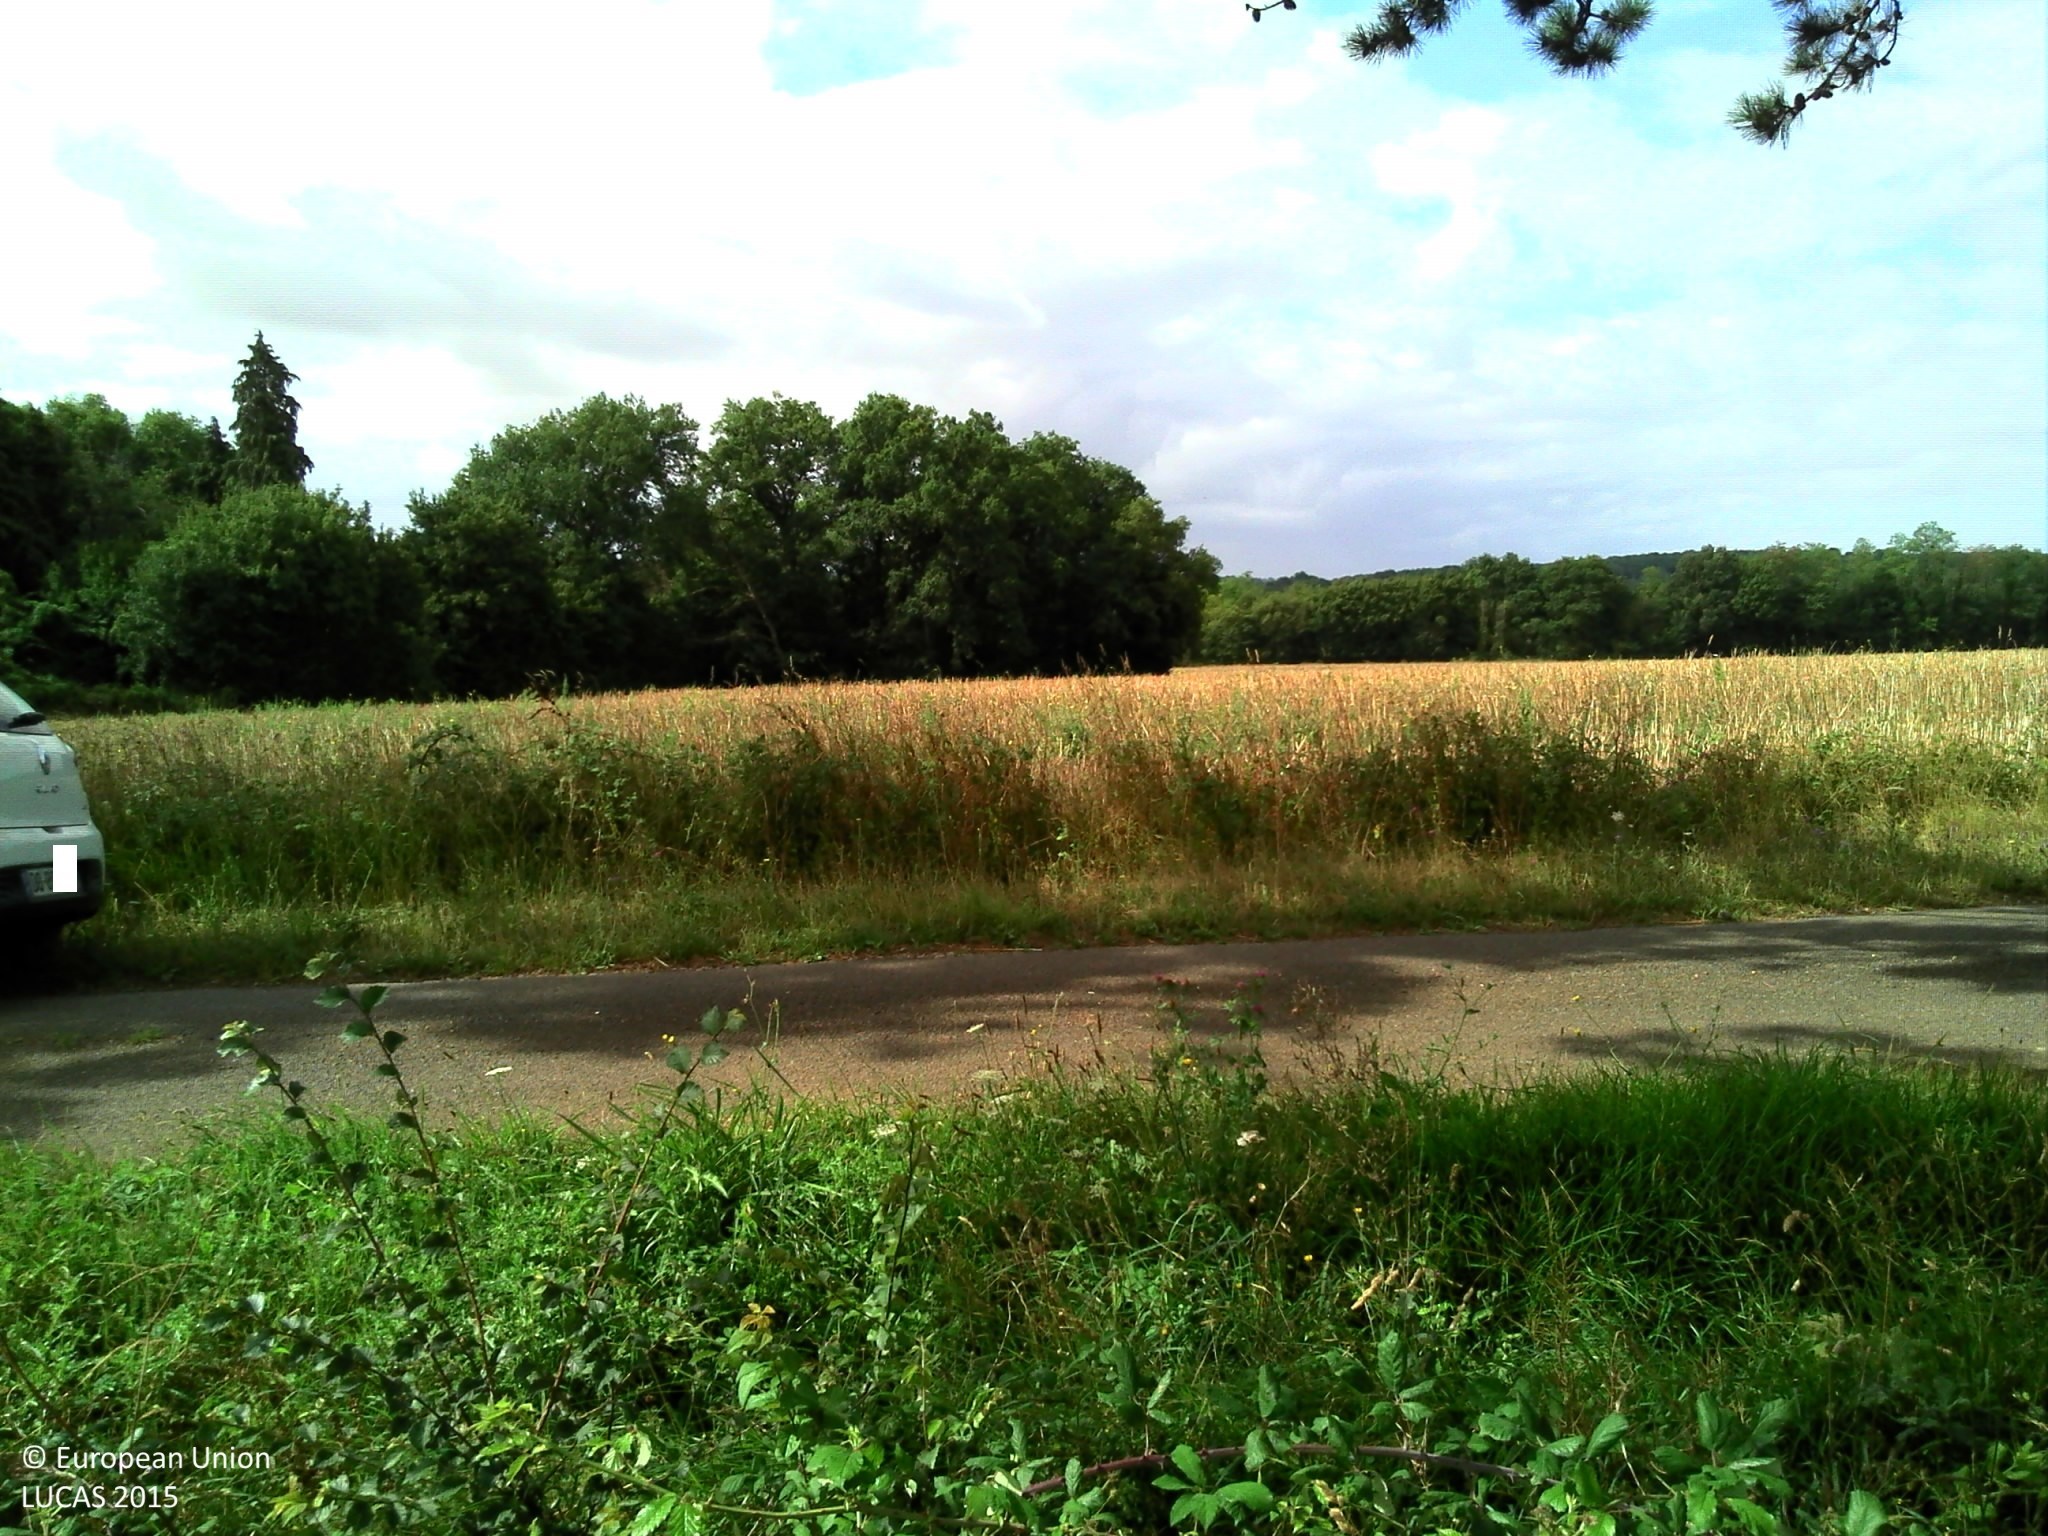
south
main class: Cropland
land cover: Maize
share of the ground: > 75 %
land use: Agriculture (excluding fallow land and kitchen gardens)
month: July
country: FR
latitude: 46.3424
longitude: 0.2758
